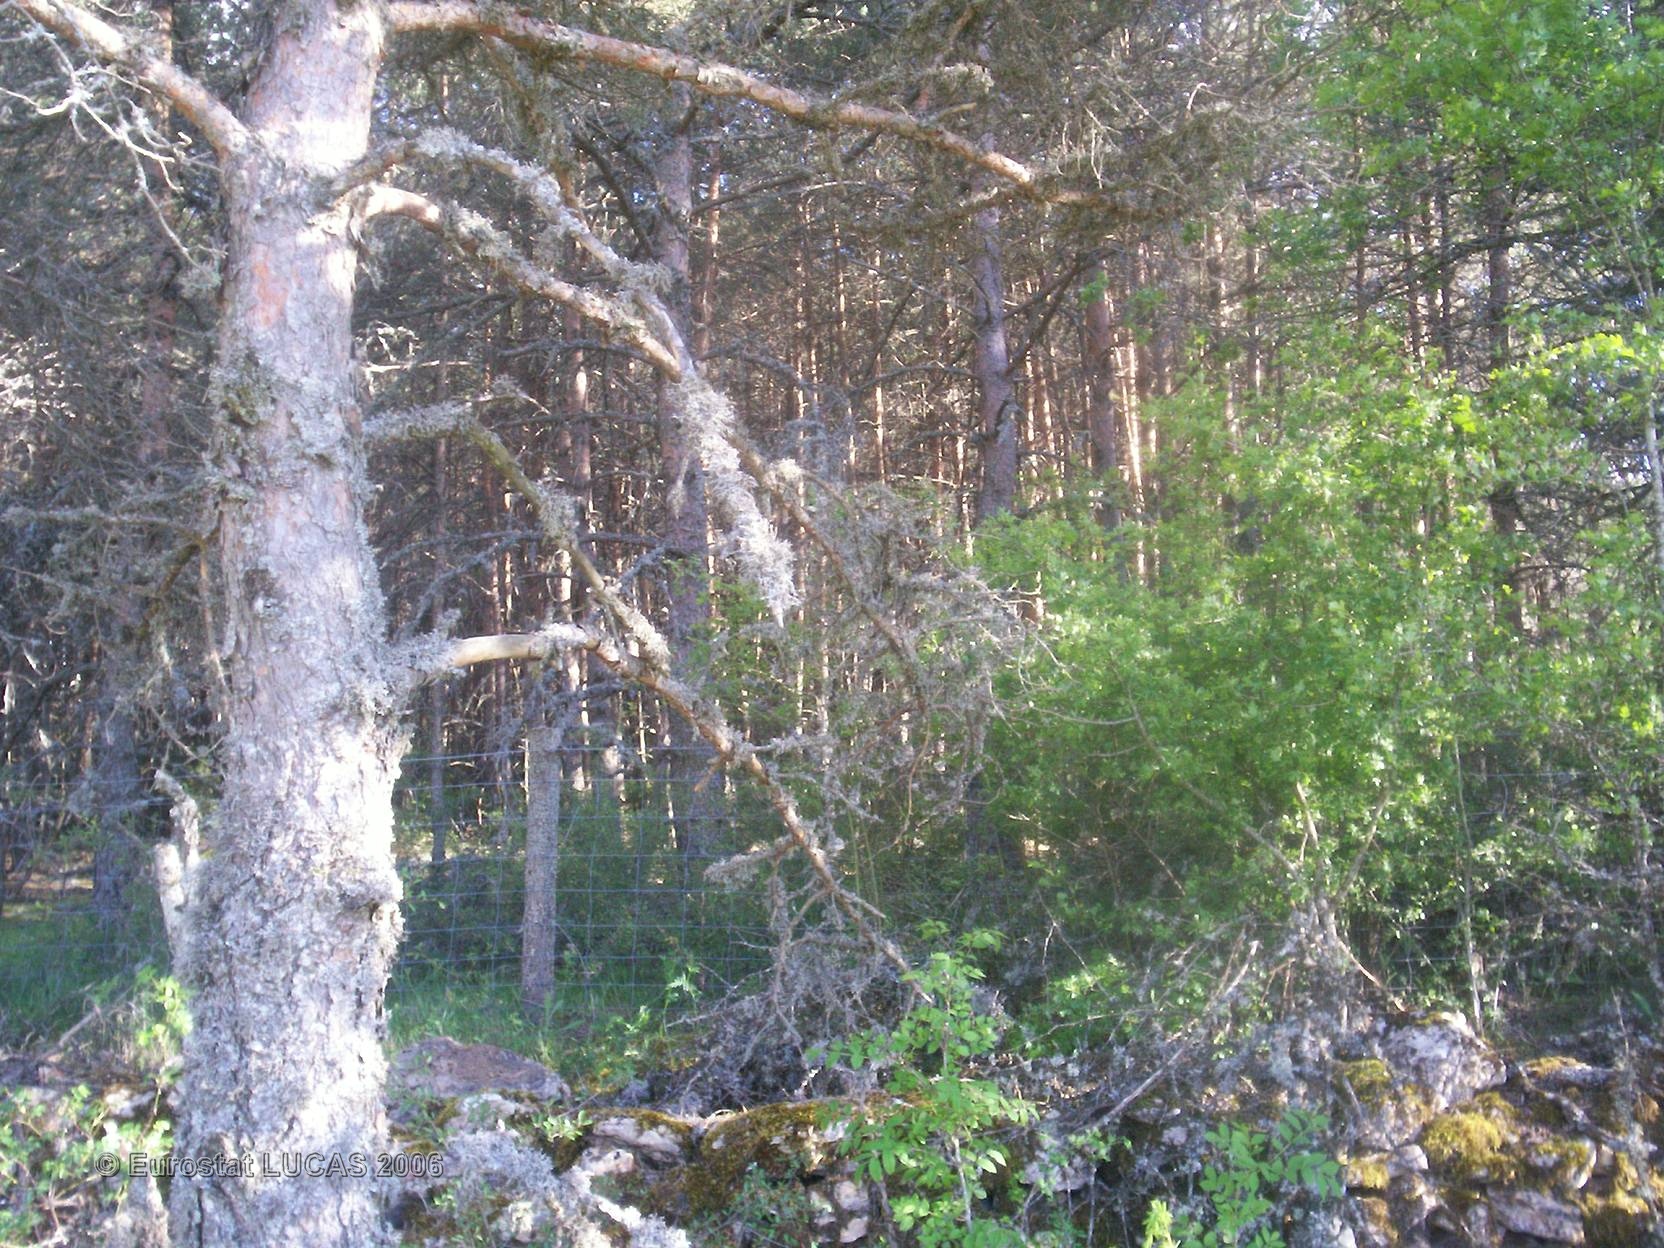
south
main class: Grassland
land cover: Grassland without tree/shrub cover
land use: Agriculture (excluding fallow land and kitchen gardens)
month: June
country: FR
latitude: 44.2868
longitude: 3.4269
